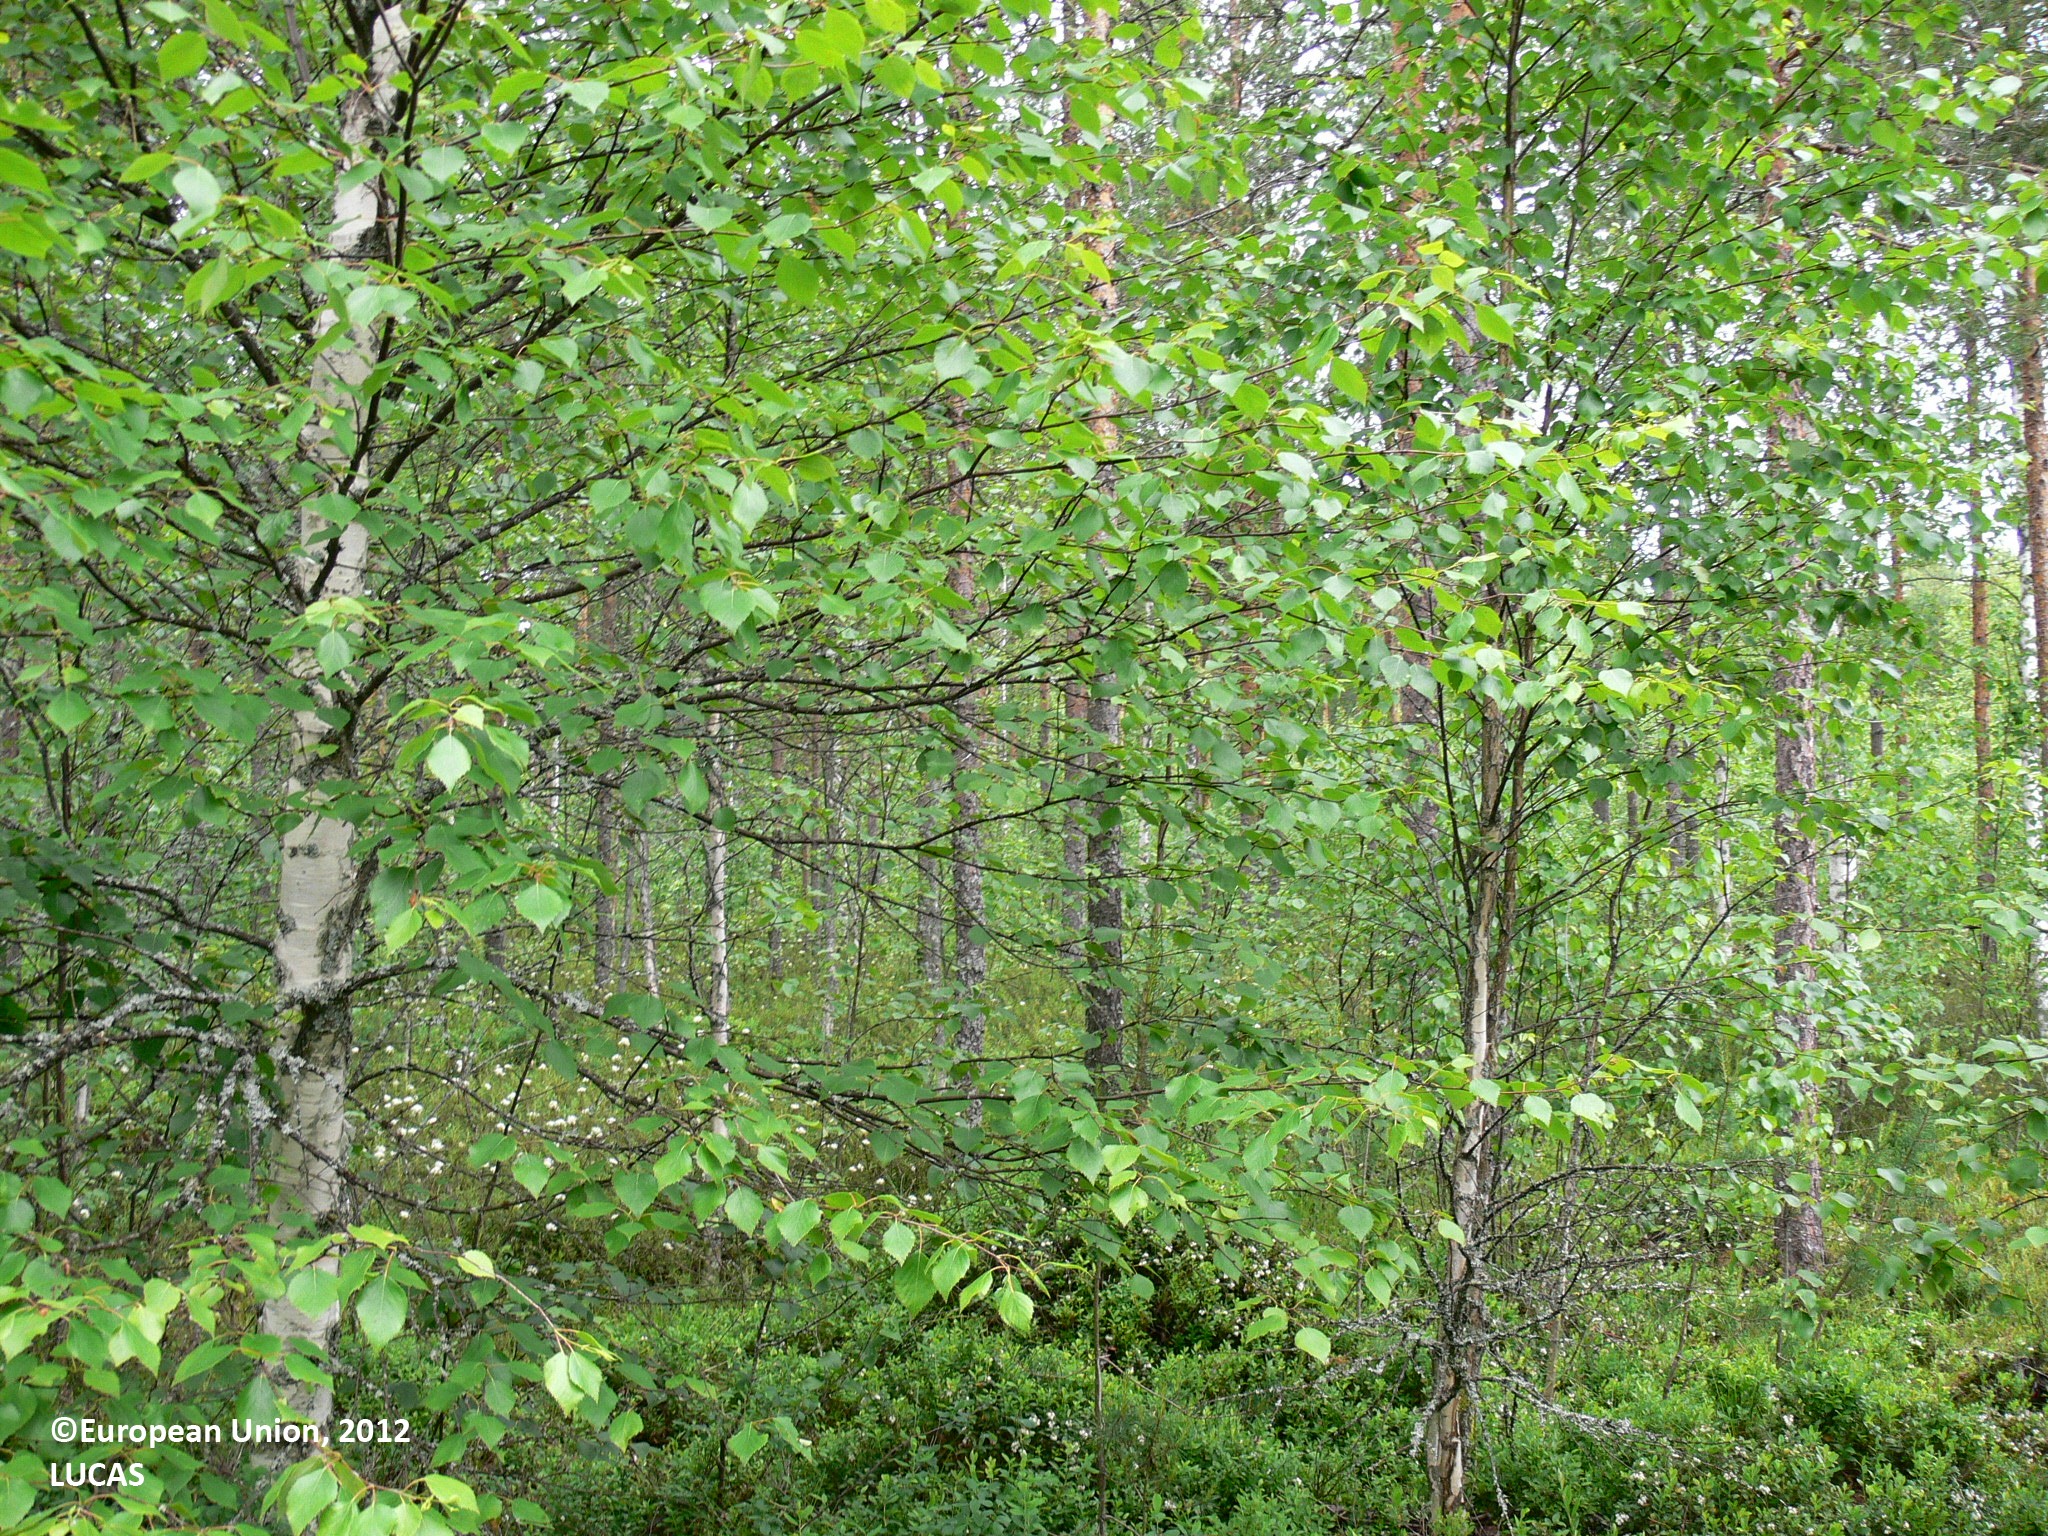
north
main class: Woodland
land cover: Pine dominated mixed woodland
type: boreal forest
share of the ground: 50 - 75 %
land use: Forestry
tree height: > 5 m
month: June
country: FI
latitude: 62.9323
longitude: 29.4374
